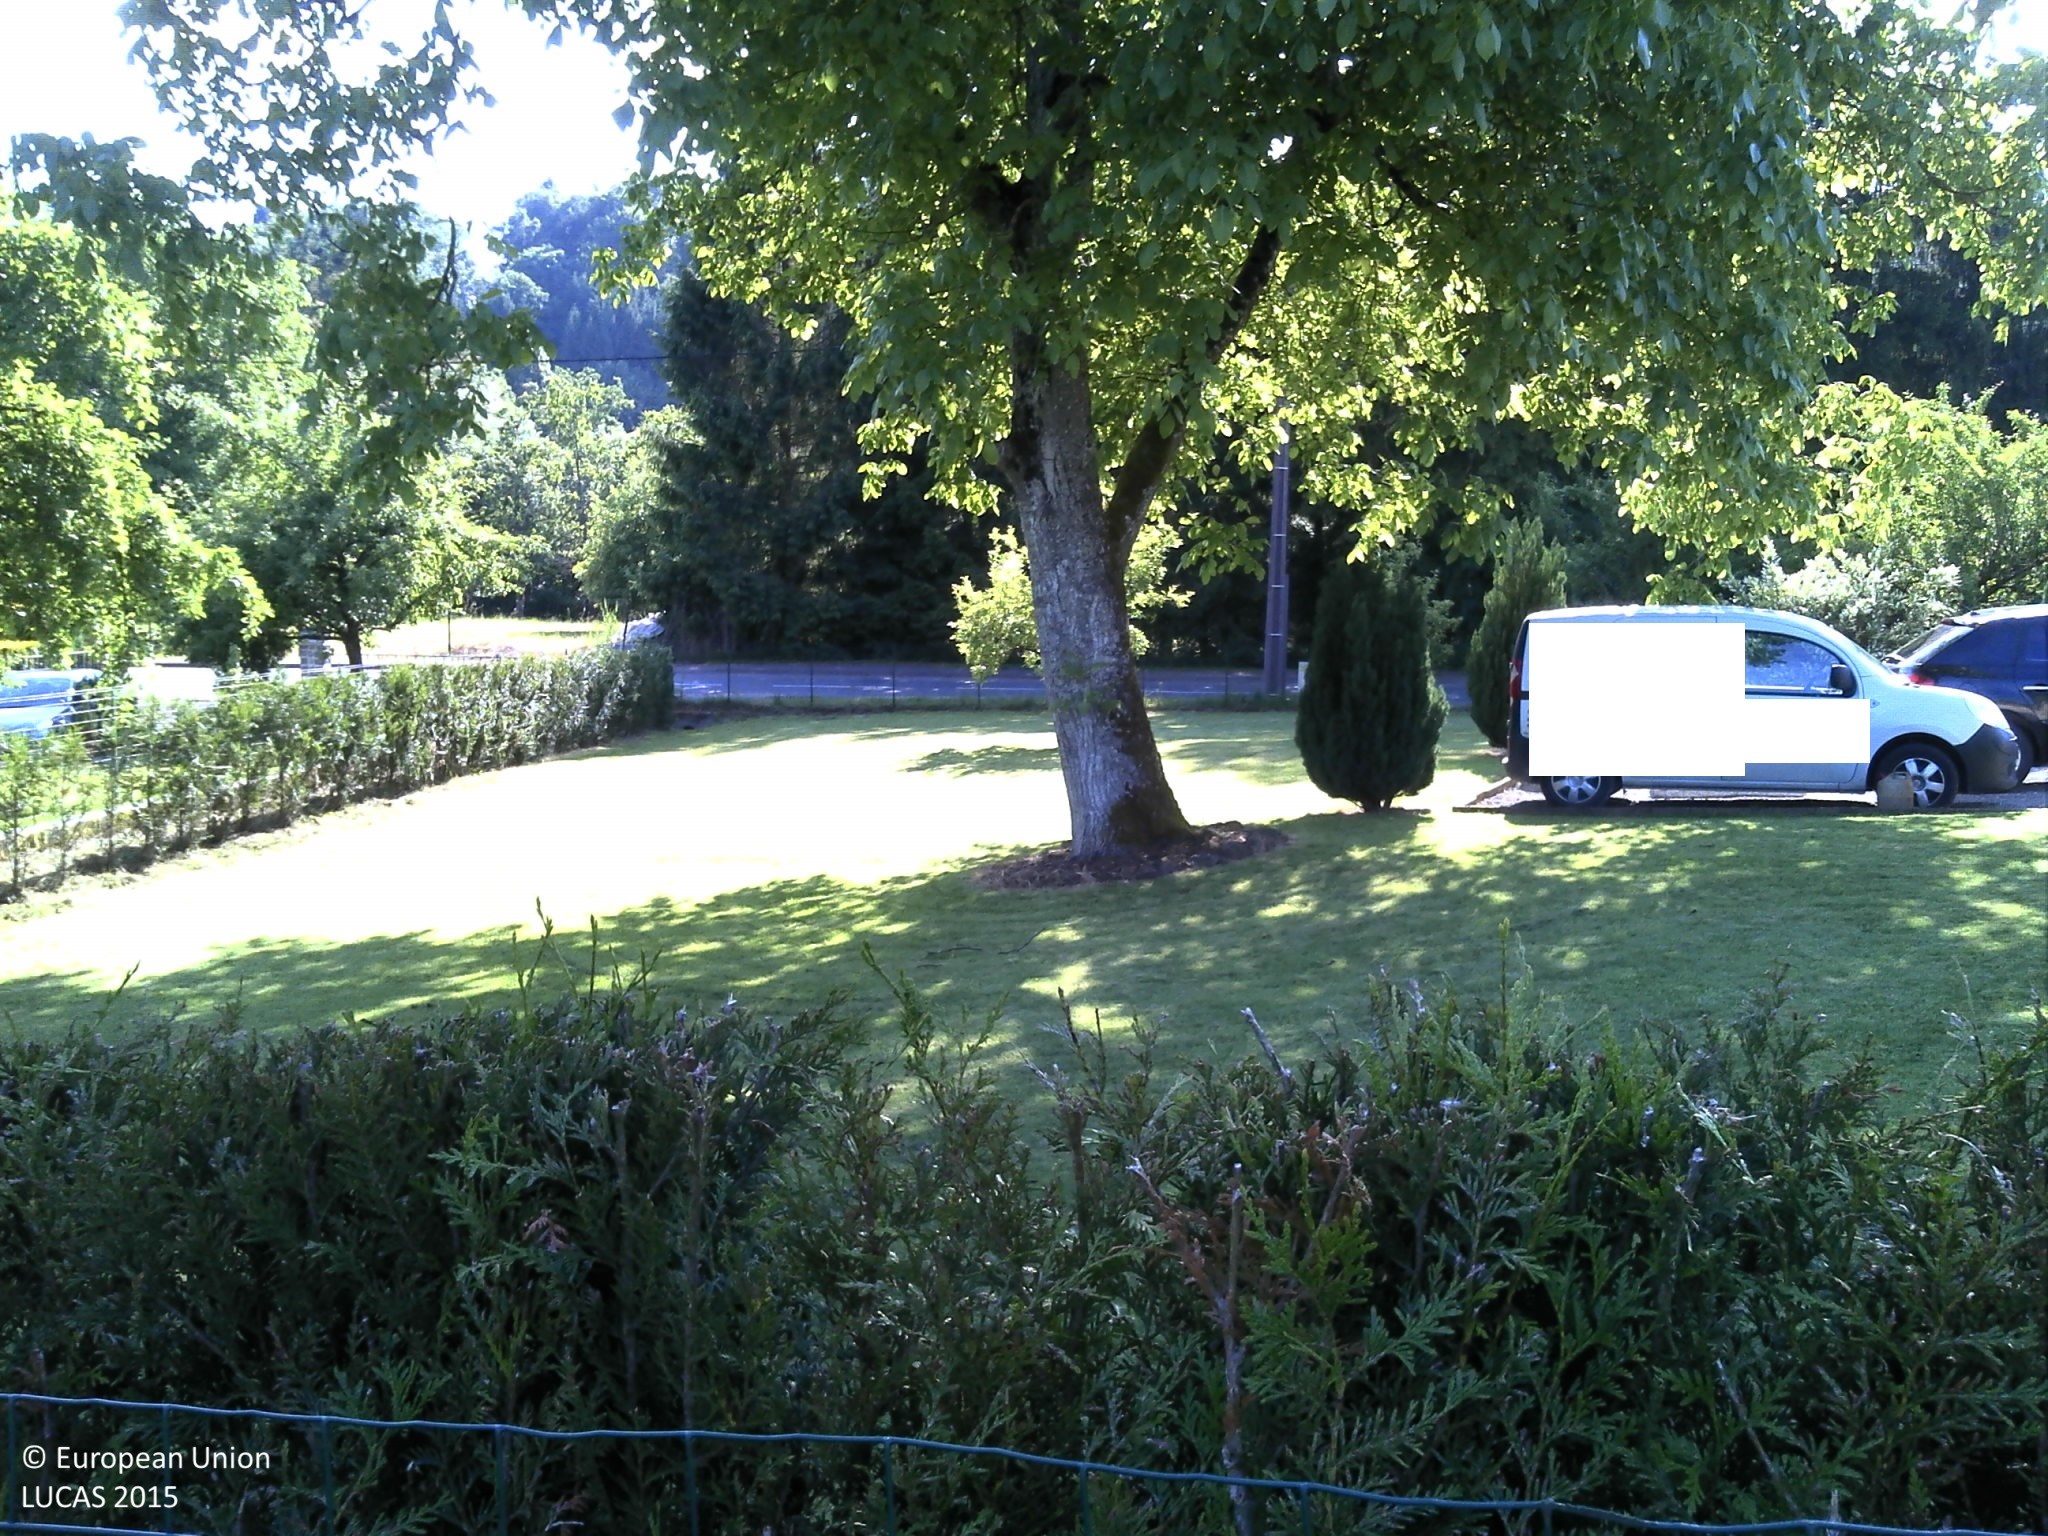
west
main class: Grassland
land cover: Grassland without tree/shrub cover
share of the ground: > 75 %
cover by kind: herbaceous plants 100 %
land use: Residential
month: June
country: FR
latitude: 49.6983
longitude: 5.0480
